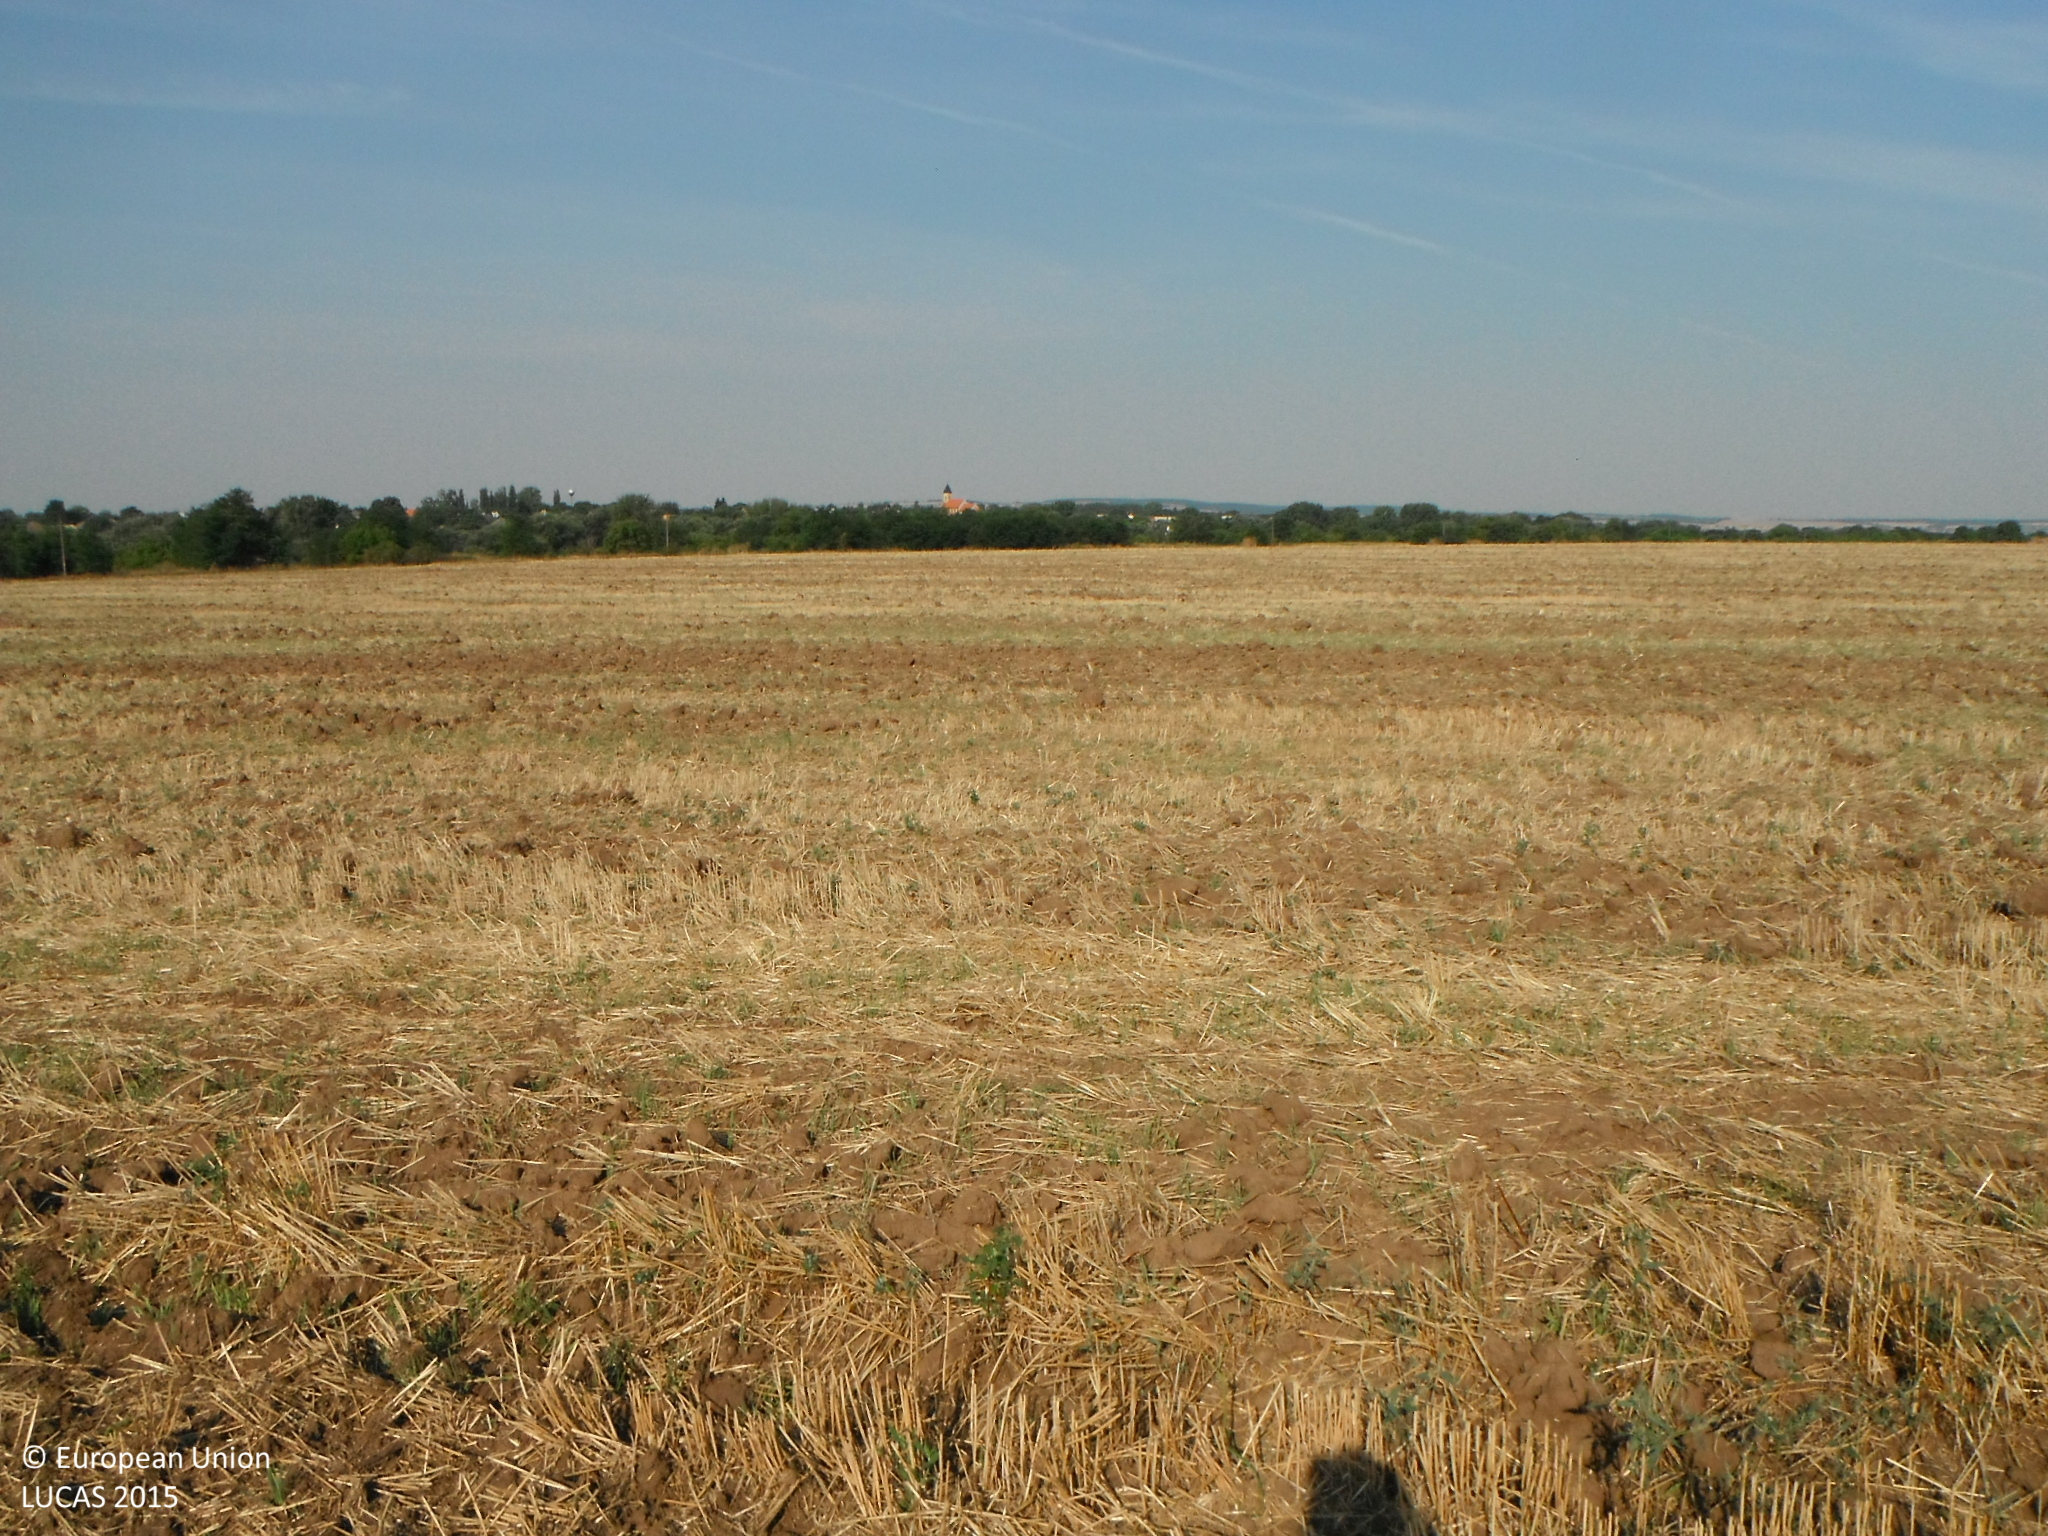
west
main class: Cropland
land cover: Common wheat
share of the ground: < 10 %
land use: Agriculture (excluding fallow land and kitchen gardens)
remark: Harvested field
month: August
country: SK
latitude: 47.9236
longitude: 18.5944
